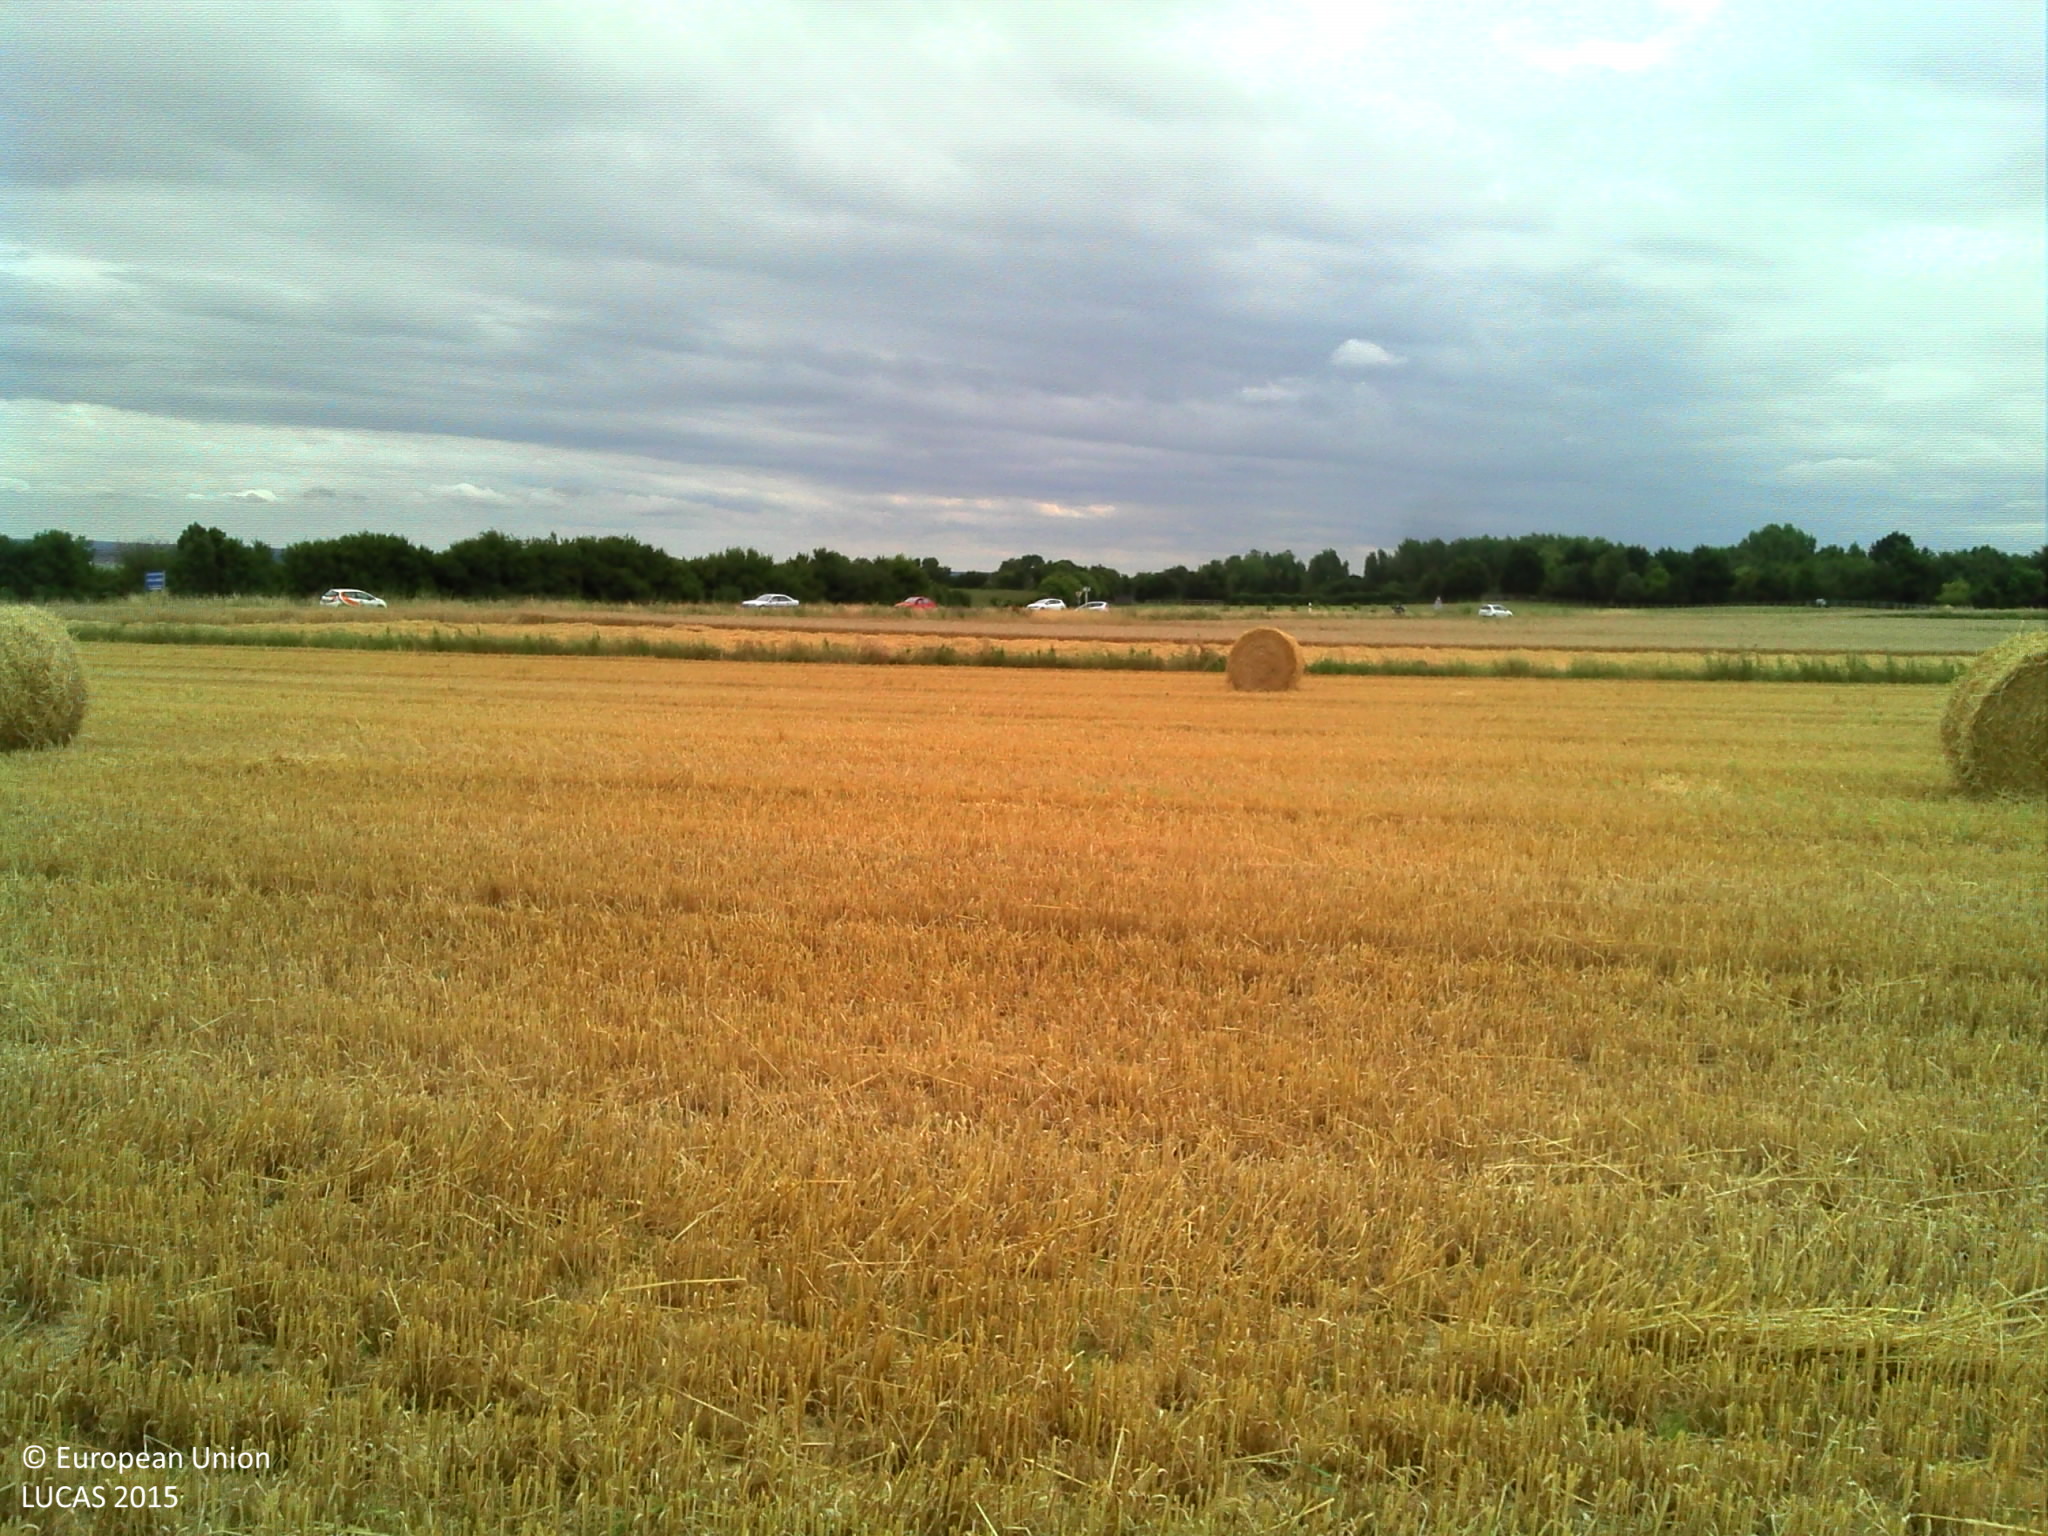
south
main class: Cropland
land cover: Barley
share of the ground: > 75 %
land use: Agriculture (excluding fallow land and kitchen gardens)
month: July
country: FR
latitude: 48.6519
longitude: -1.8760
